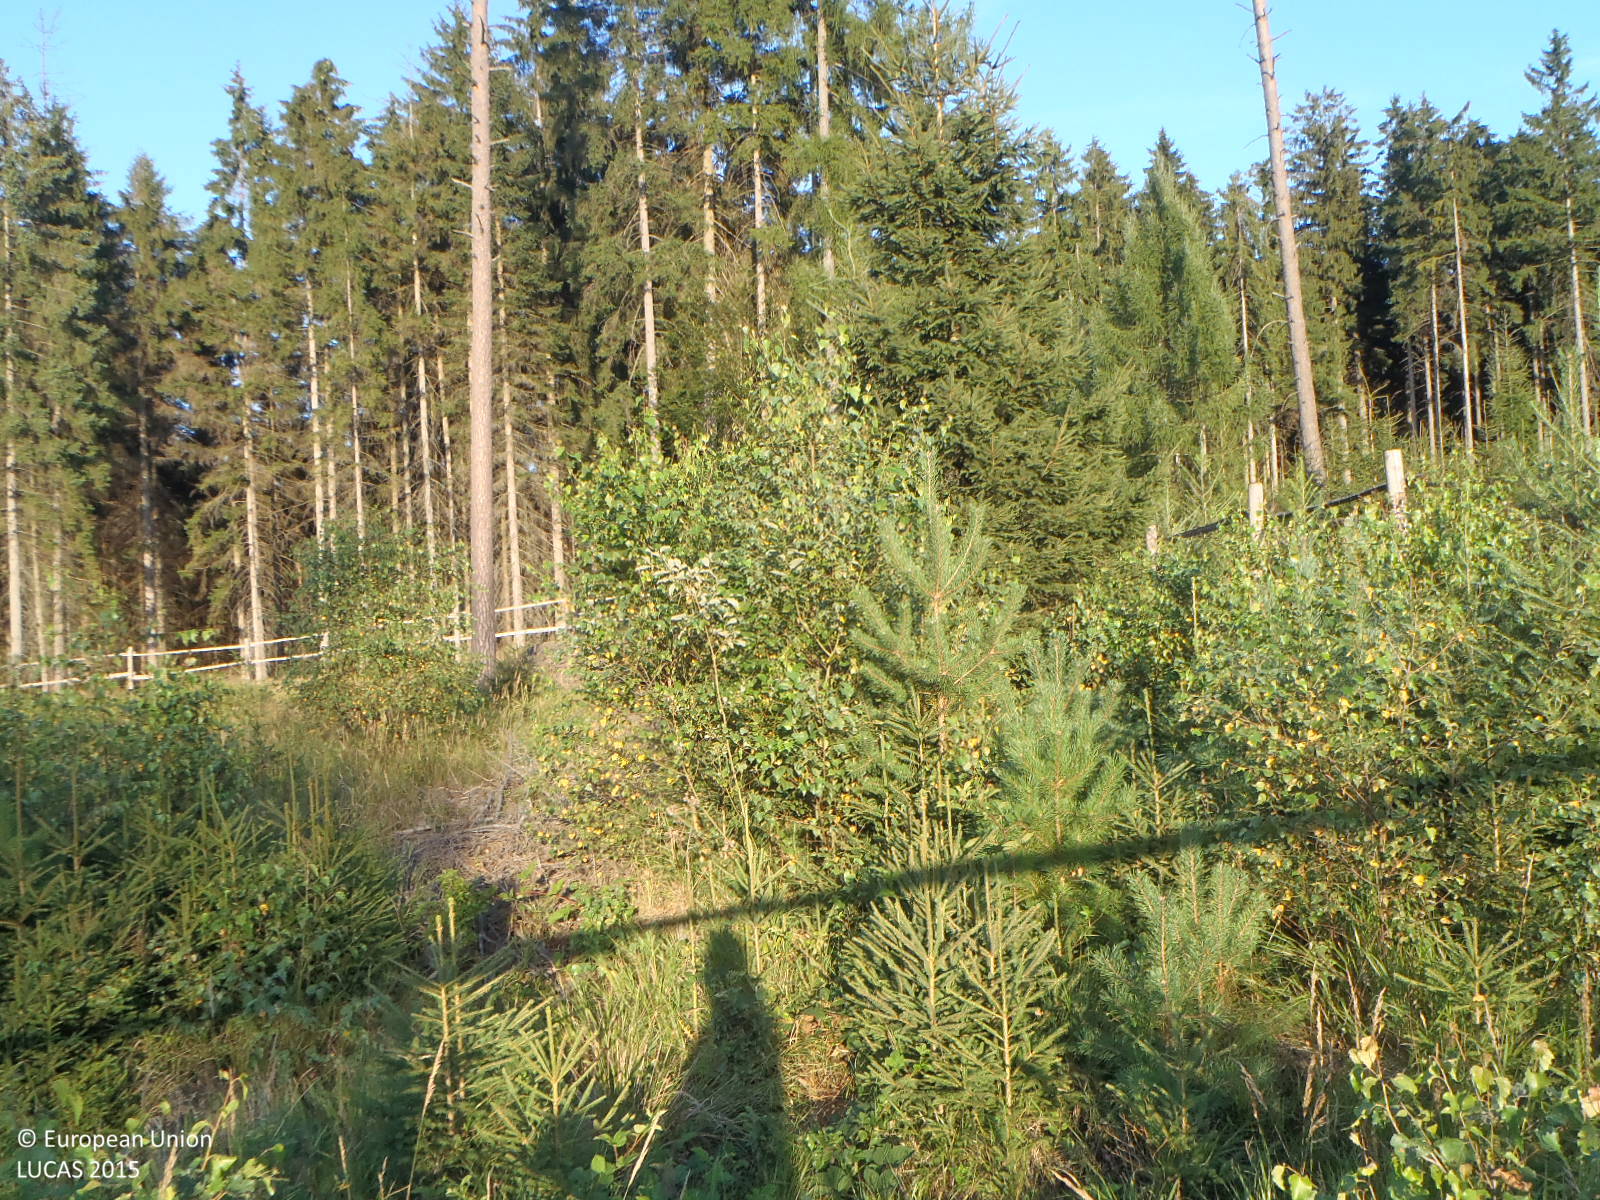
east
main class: Woodland
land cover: Other mixed woodland
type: hemiboreal forest and nemoral coniferous forest and mixed broadleaved-coniferous forest
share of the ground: 50 - 75 %
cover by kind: herbaceous plants 45 %, coniferous forest trees 25 %, broadleaved forest trees 25 %, shrubs 5 %
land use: Forestry
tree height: < 5 m
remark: Nursery
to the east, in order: Other mixed woodland; Ditches and canals; Other mixed woodland; Fences; Spruce dominated coniferous woodland; Ditches and canals; Tracks; Spruce dominated coniferous woodland; Fences; Other mixed woodland; Fences; Grassland without tree/shrub cover; Ditches and canals; Tracks; Grass margins; Ditches and canals; Spruce dominated coniferous woodland
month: August
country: CZ
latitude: 50.8685
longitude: 14.5347
